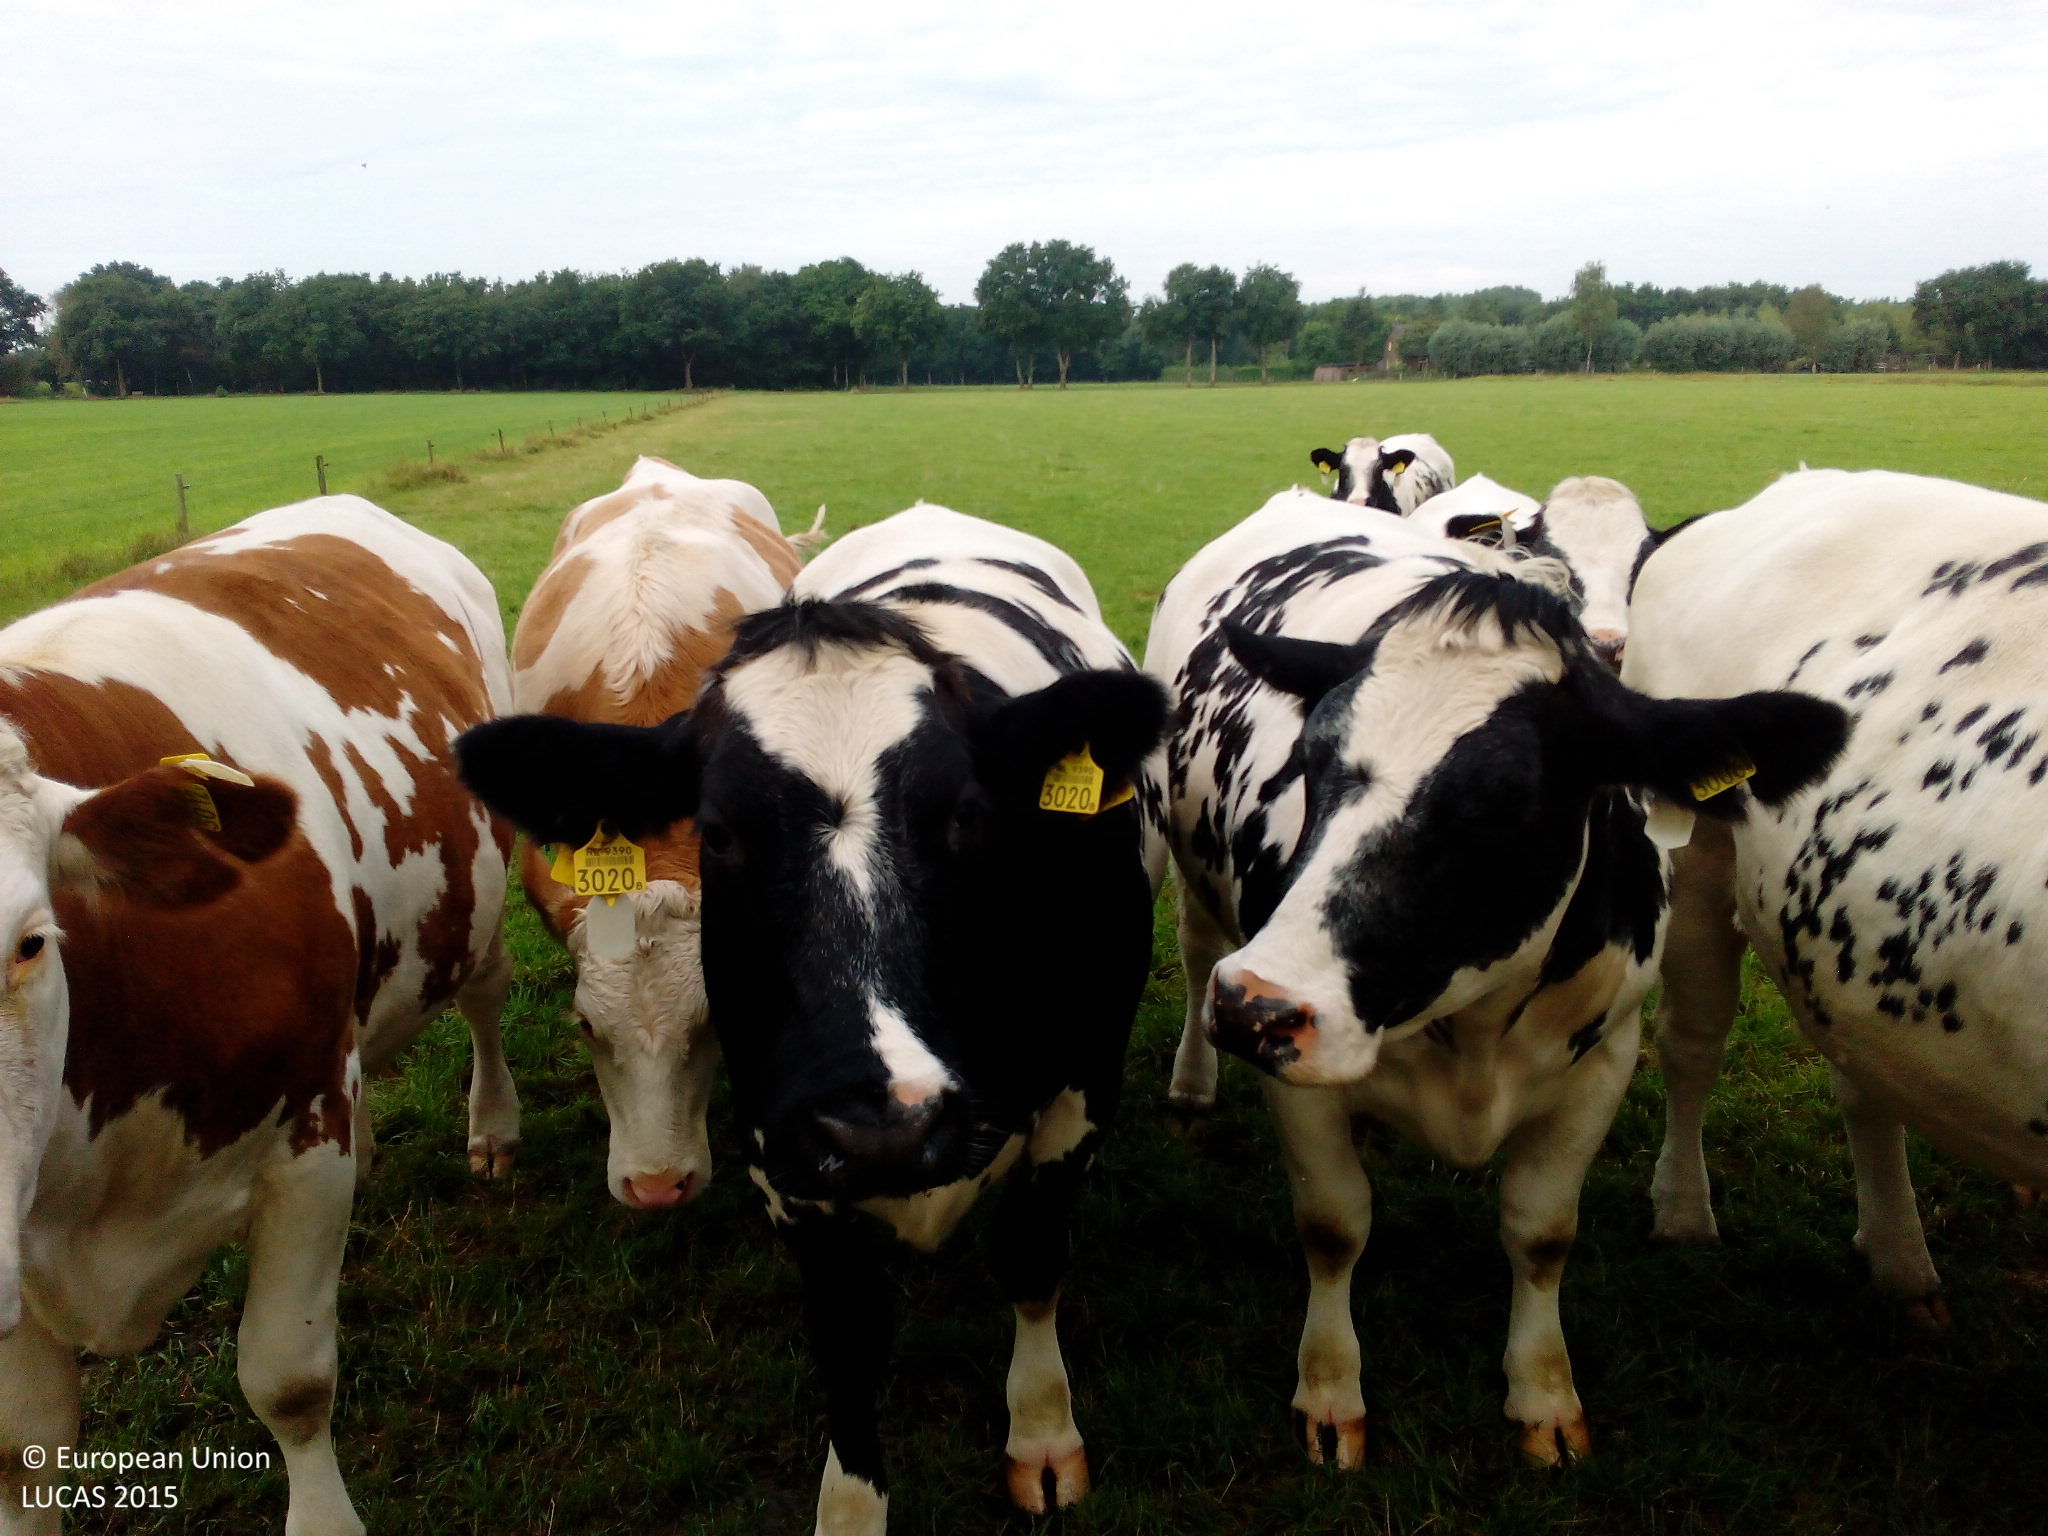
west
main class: Grassland
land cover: Grassland without tree/shrub cover
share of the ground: > 75 %
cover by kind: herbaceous plants 100 %
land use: Agriculture (excluding fallow land and kitchen gardens)
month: August
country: NL
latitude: 51.6644
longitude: 5.5598
